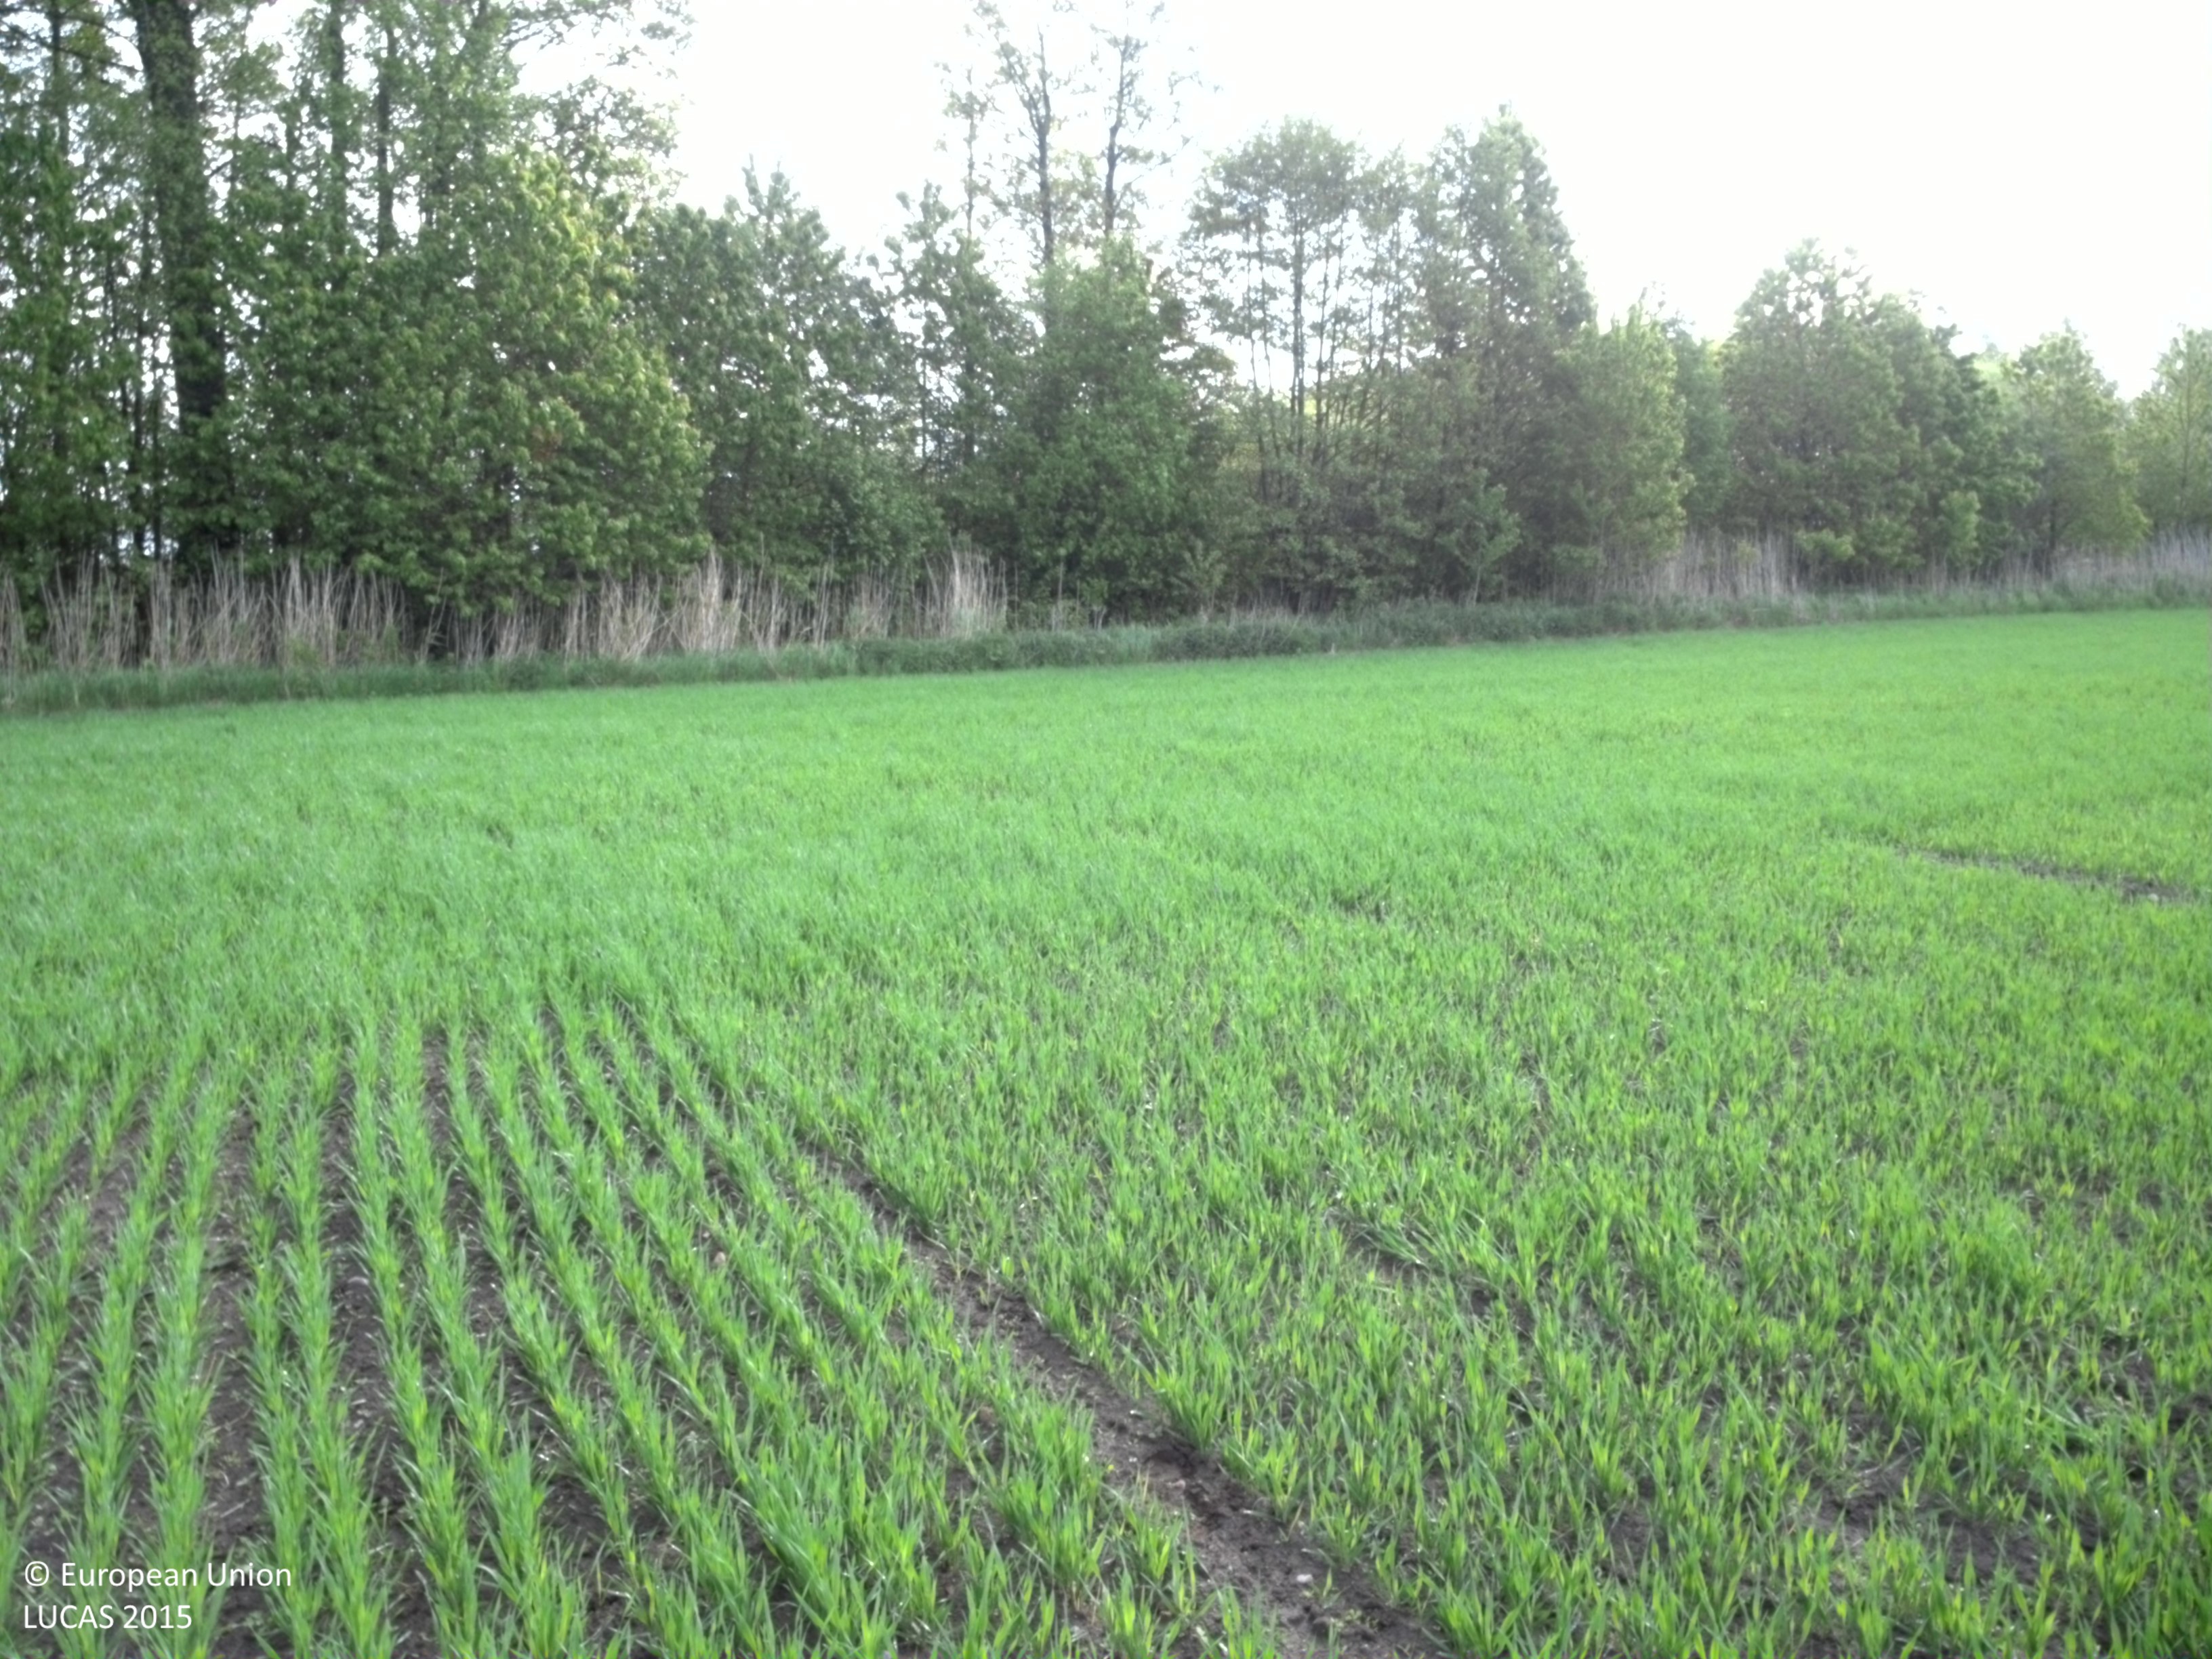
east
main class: Cropland
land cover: Oats
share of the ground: 50 - 75 %
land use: Agriculture (excluding fallow land and kitchen gardens)
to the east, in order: Oats; Broadleaved woodland; Shrubland with sparse tree cover; Inland marshes; Inland fresh water bodies
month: June
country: SE
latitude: 56.7181
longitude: 14.5885
